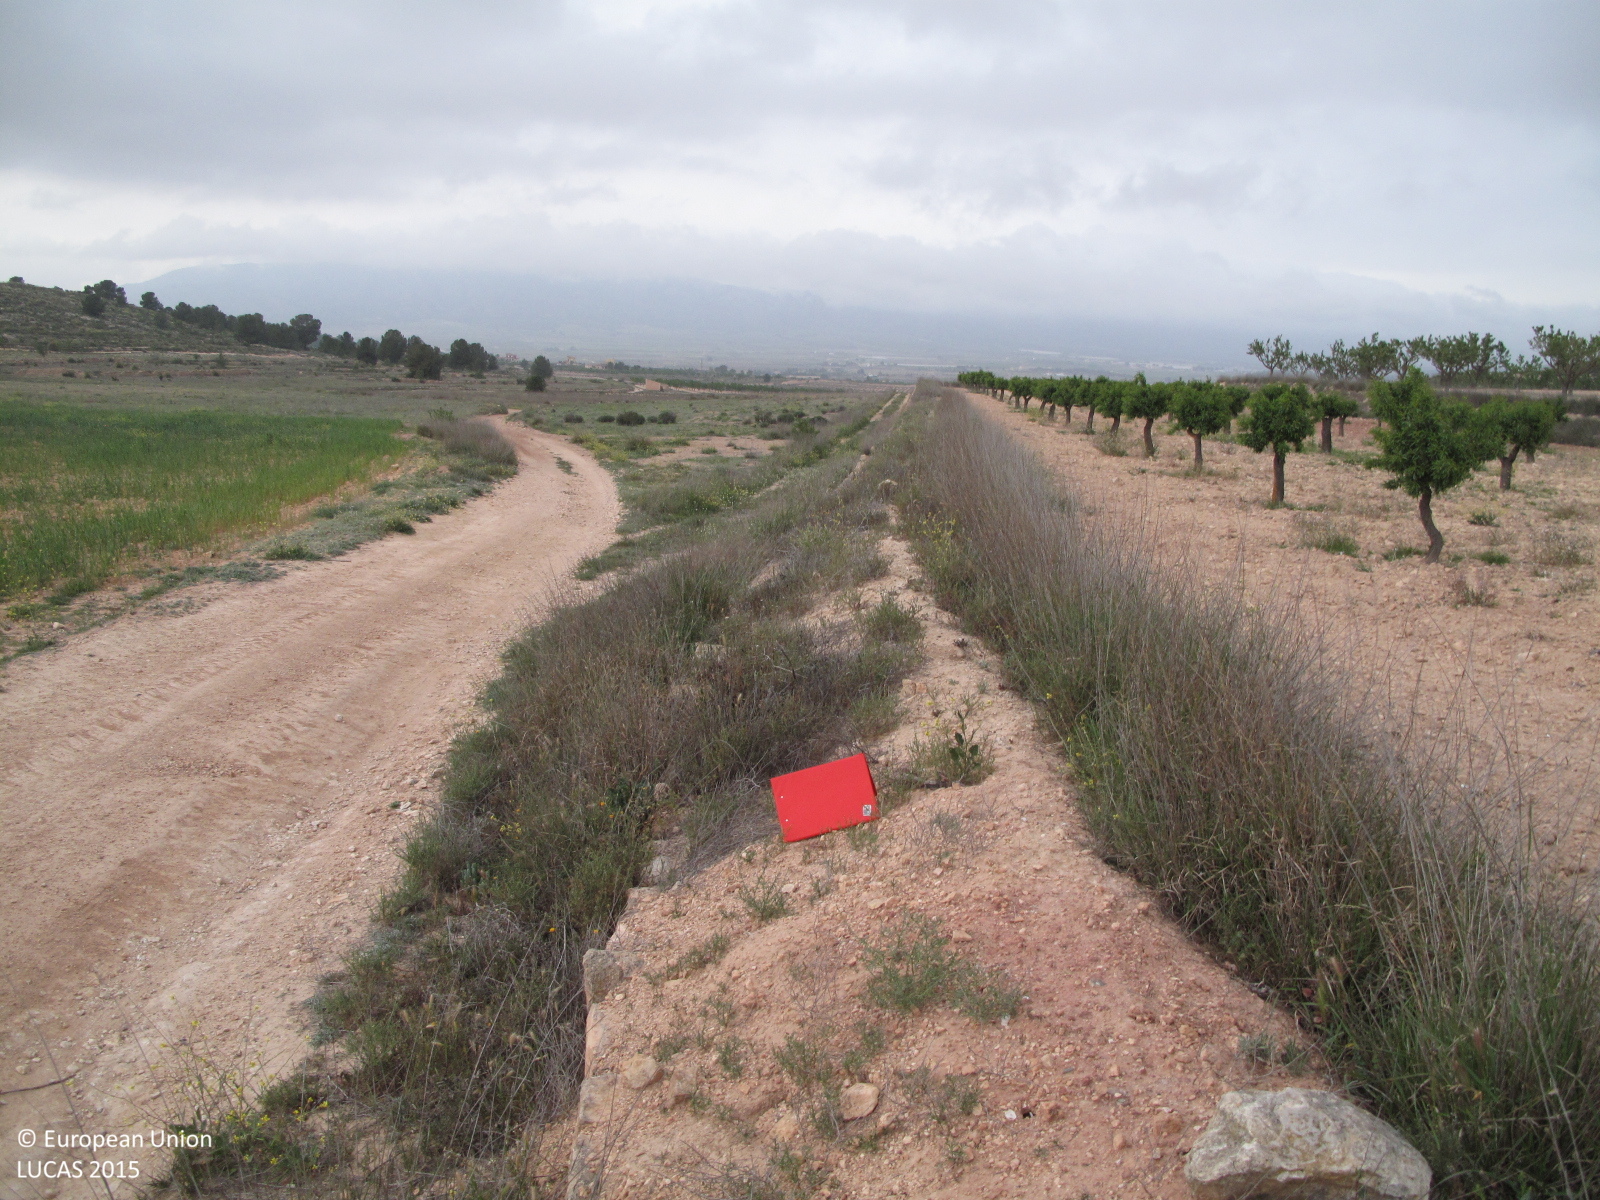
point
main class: Cropland
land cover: Nuts trees
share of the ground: < 10 %
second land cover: Other bare soil
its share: > 75 %
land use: Agriculture (excluding fallow land and kitchen gardens)
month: April
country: ES
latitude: 38.4266
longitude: -0.9735
